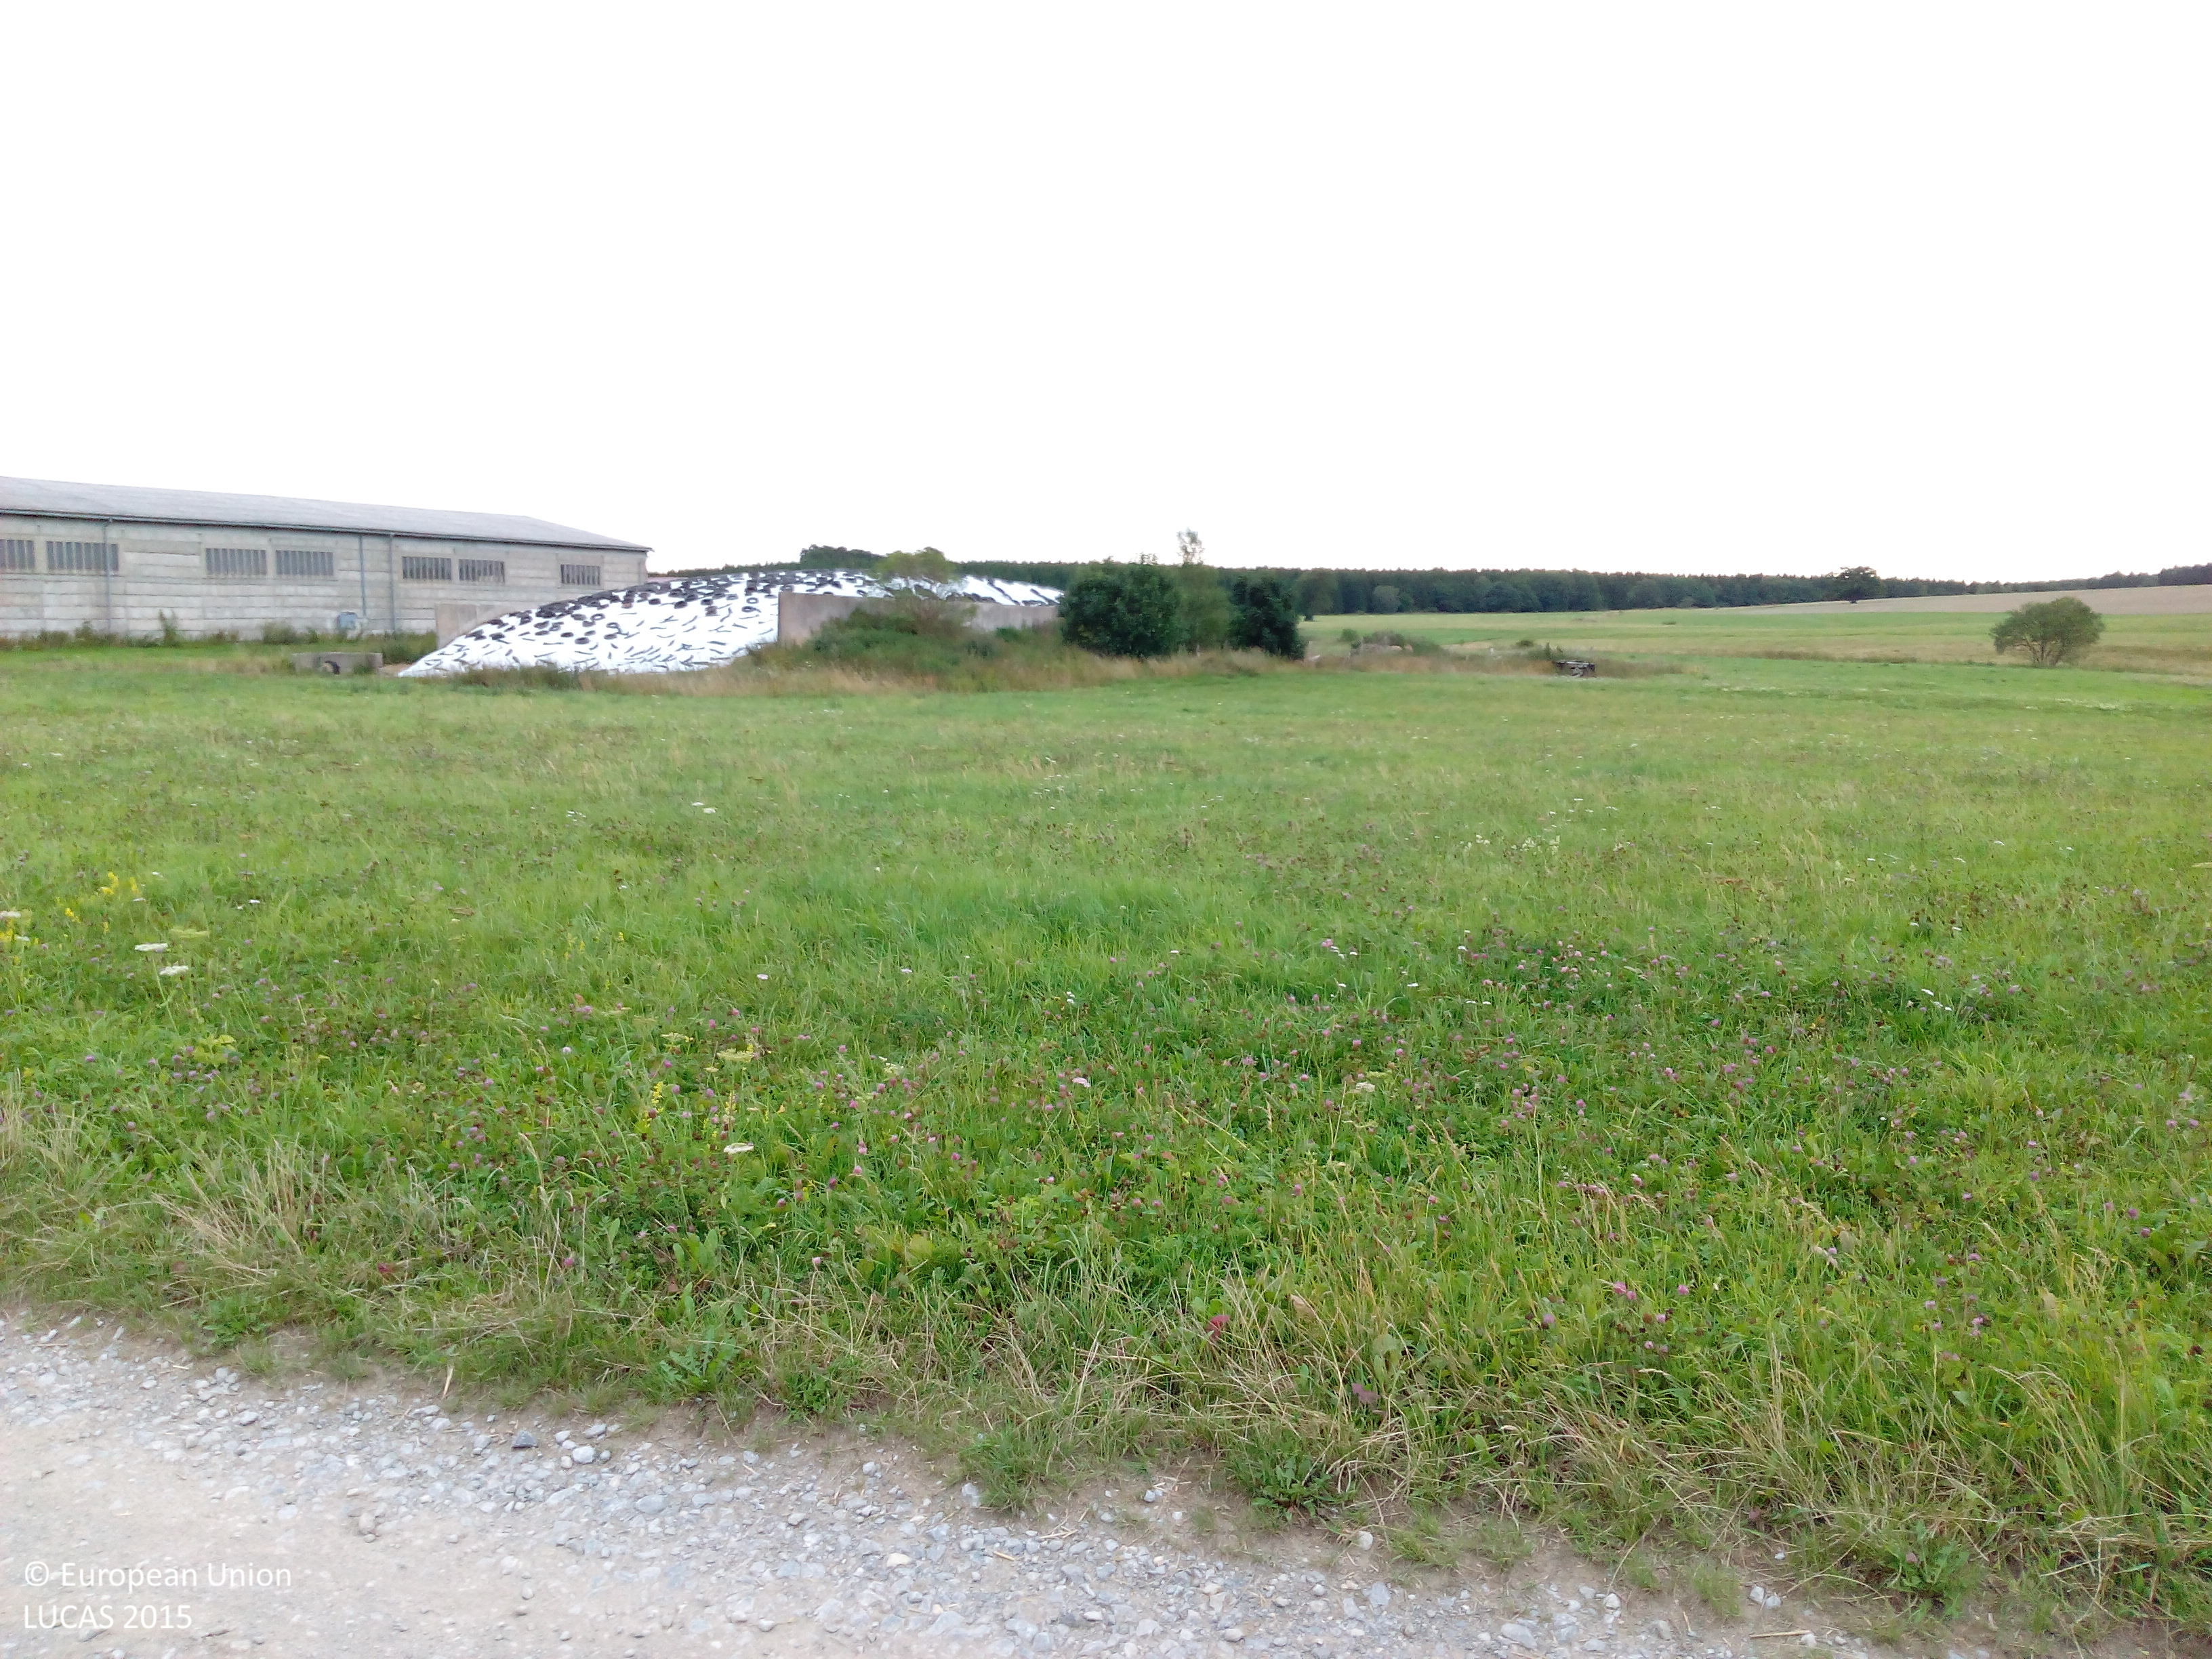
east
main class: Woodland
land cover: Other mixed woodland
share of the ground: 50 - 75 %
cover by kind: coniferous forest trees 40 %, herbaceous plants 30 %, broadleaved forest trees 25 %, shrubs 5 %
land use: Forestry
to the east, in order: Other mixed woodland; Grassland with sparse tree/shrub cover; Tracks; Fences; Grassland without tree/shrub cover; Artificial constructions in urban areas
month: August
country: DE
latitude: 51.6724
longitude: 10.9686
